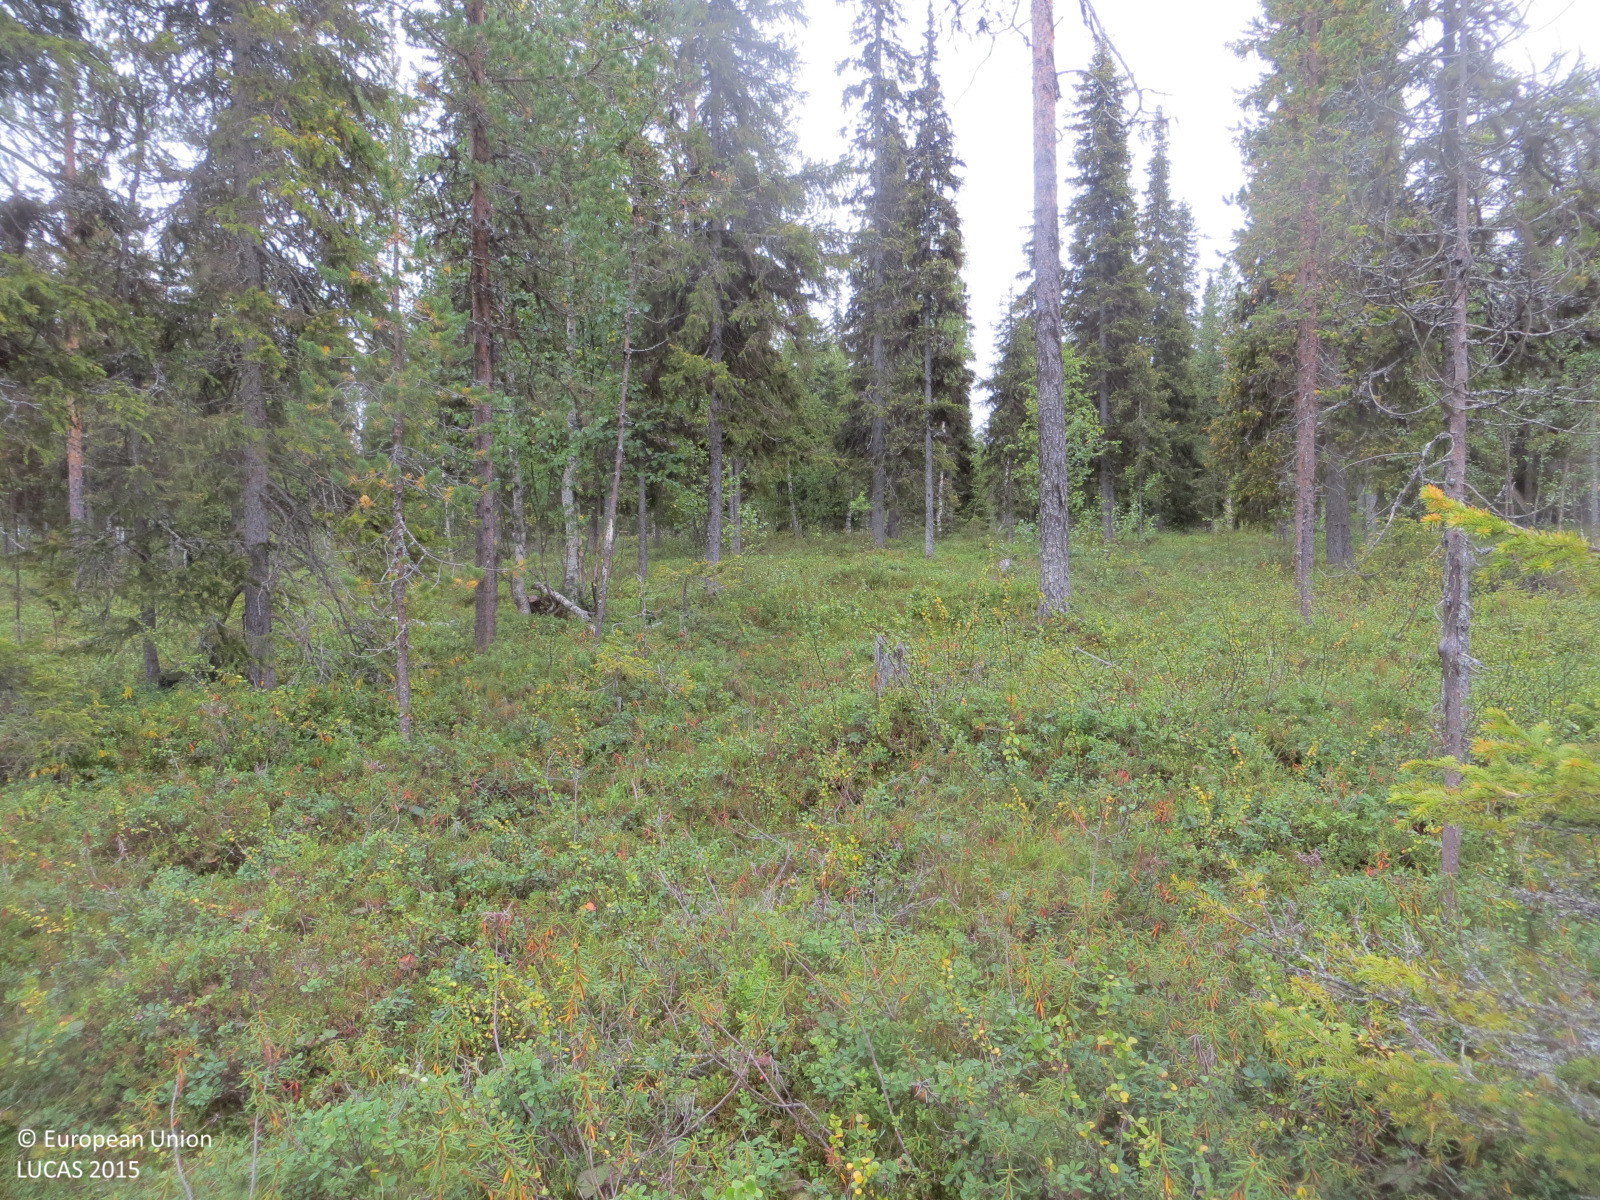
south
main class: Woodland
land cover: Pine dominated coniferous woodland
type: mire and swamp forests
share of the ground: 25 - 50 %
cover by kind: coniferous forest trees 45 %, herbaceous plants 30 %, shrubs 25 %
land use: Forestry
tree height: > 5 m
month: August
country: FI
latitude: 67.5117
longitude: 24.2949
